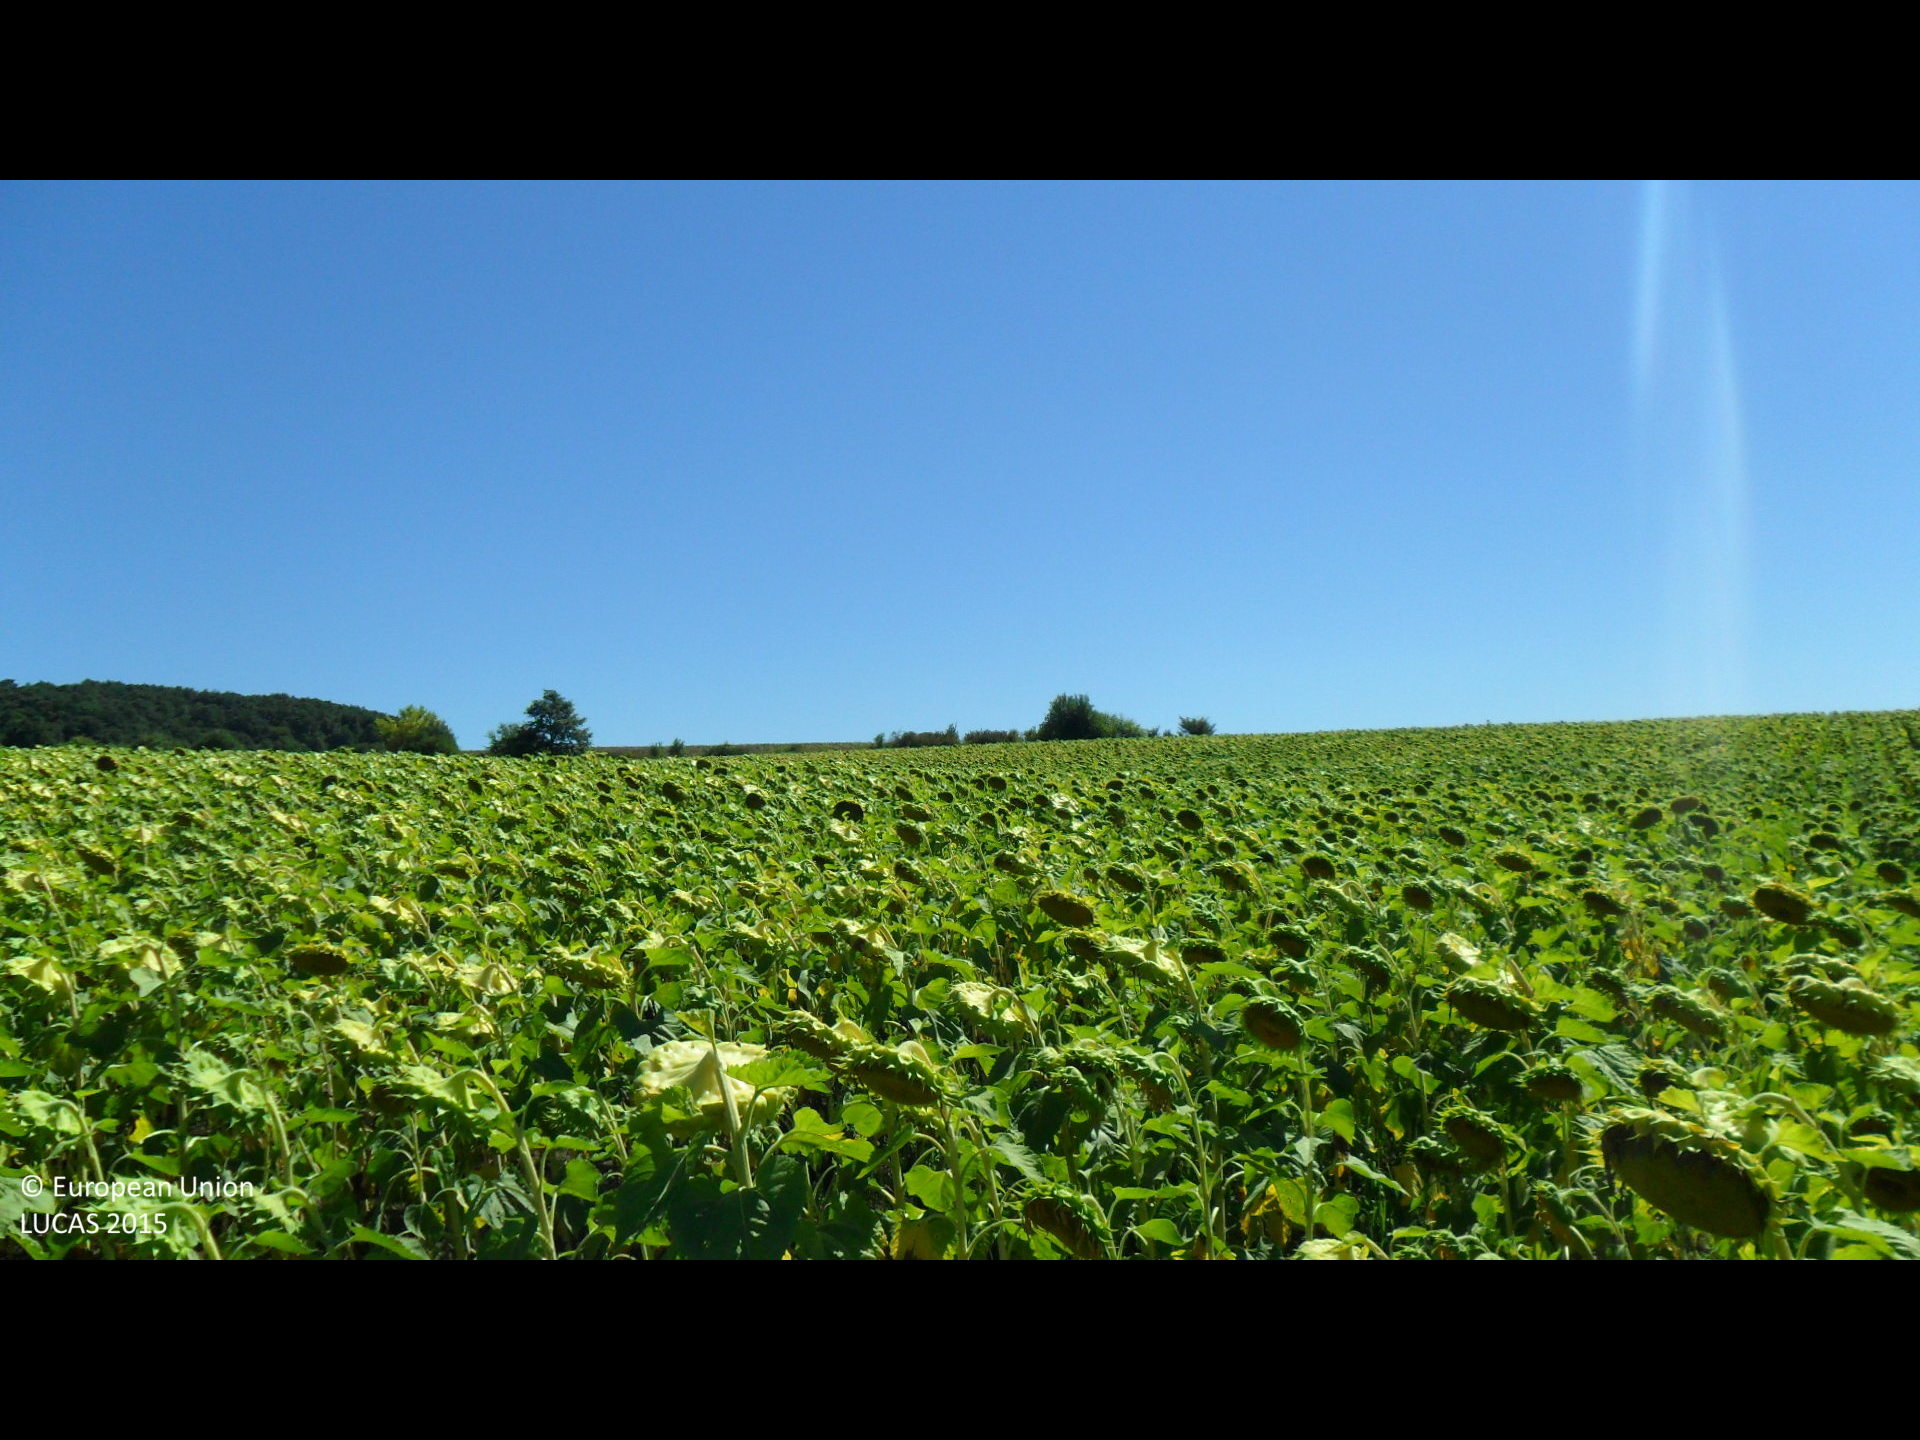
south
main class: Cropland
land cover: Sunflower
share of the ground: > 75 %
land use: Agriculture (excluding fallow land and kitchen gardens)
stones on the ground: < 10 %
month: September
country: BG
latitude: 43.1214
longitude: 26.4332
